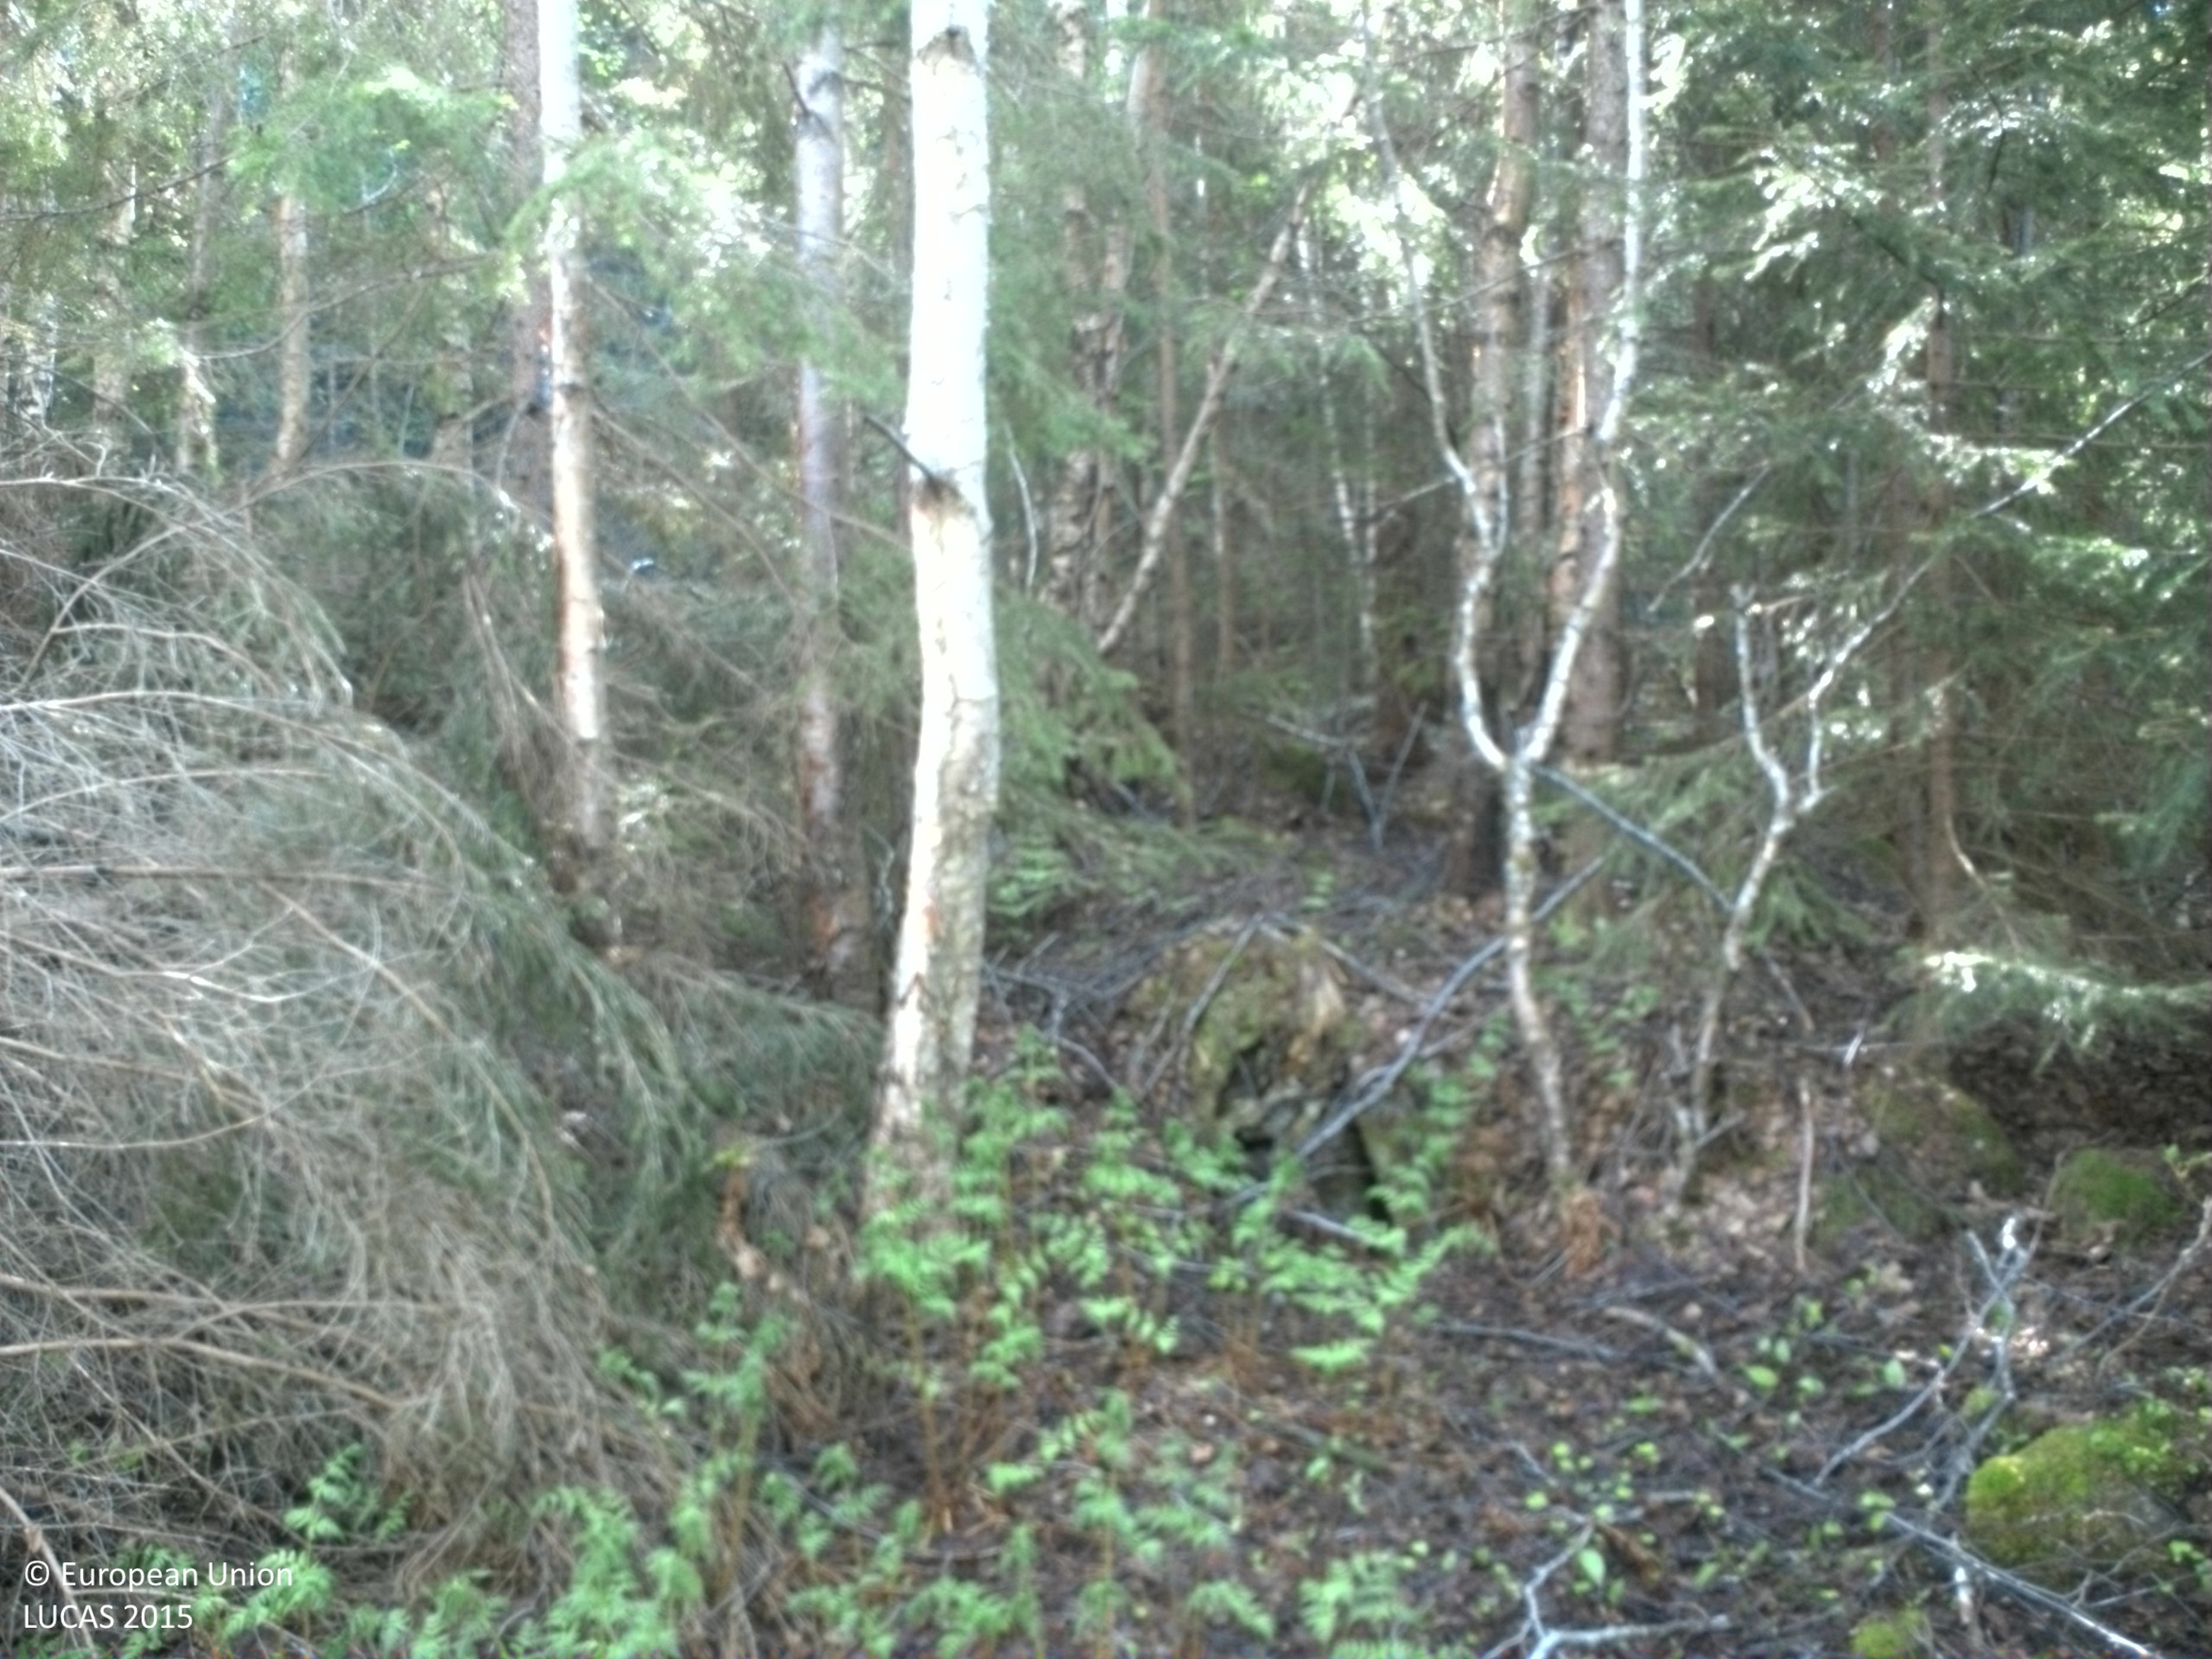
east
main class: Woodland
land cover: Other mixed woodland
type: boreal forest
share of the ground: > 75 %
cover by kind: broadleaved forest trees 60 %, coniferous forest trees 20 %, consolidated bare surface 20 %
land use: Forestry
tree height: > 5 m
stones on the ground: 25 - 50 %
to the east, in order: Other mixed woodland; Pine dominated coniferous woodland
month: May
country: SE
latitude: 62.8061
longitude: 18.1981
